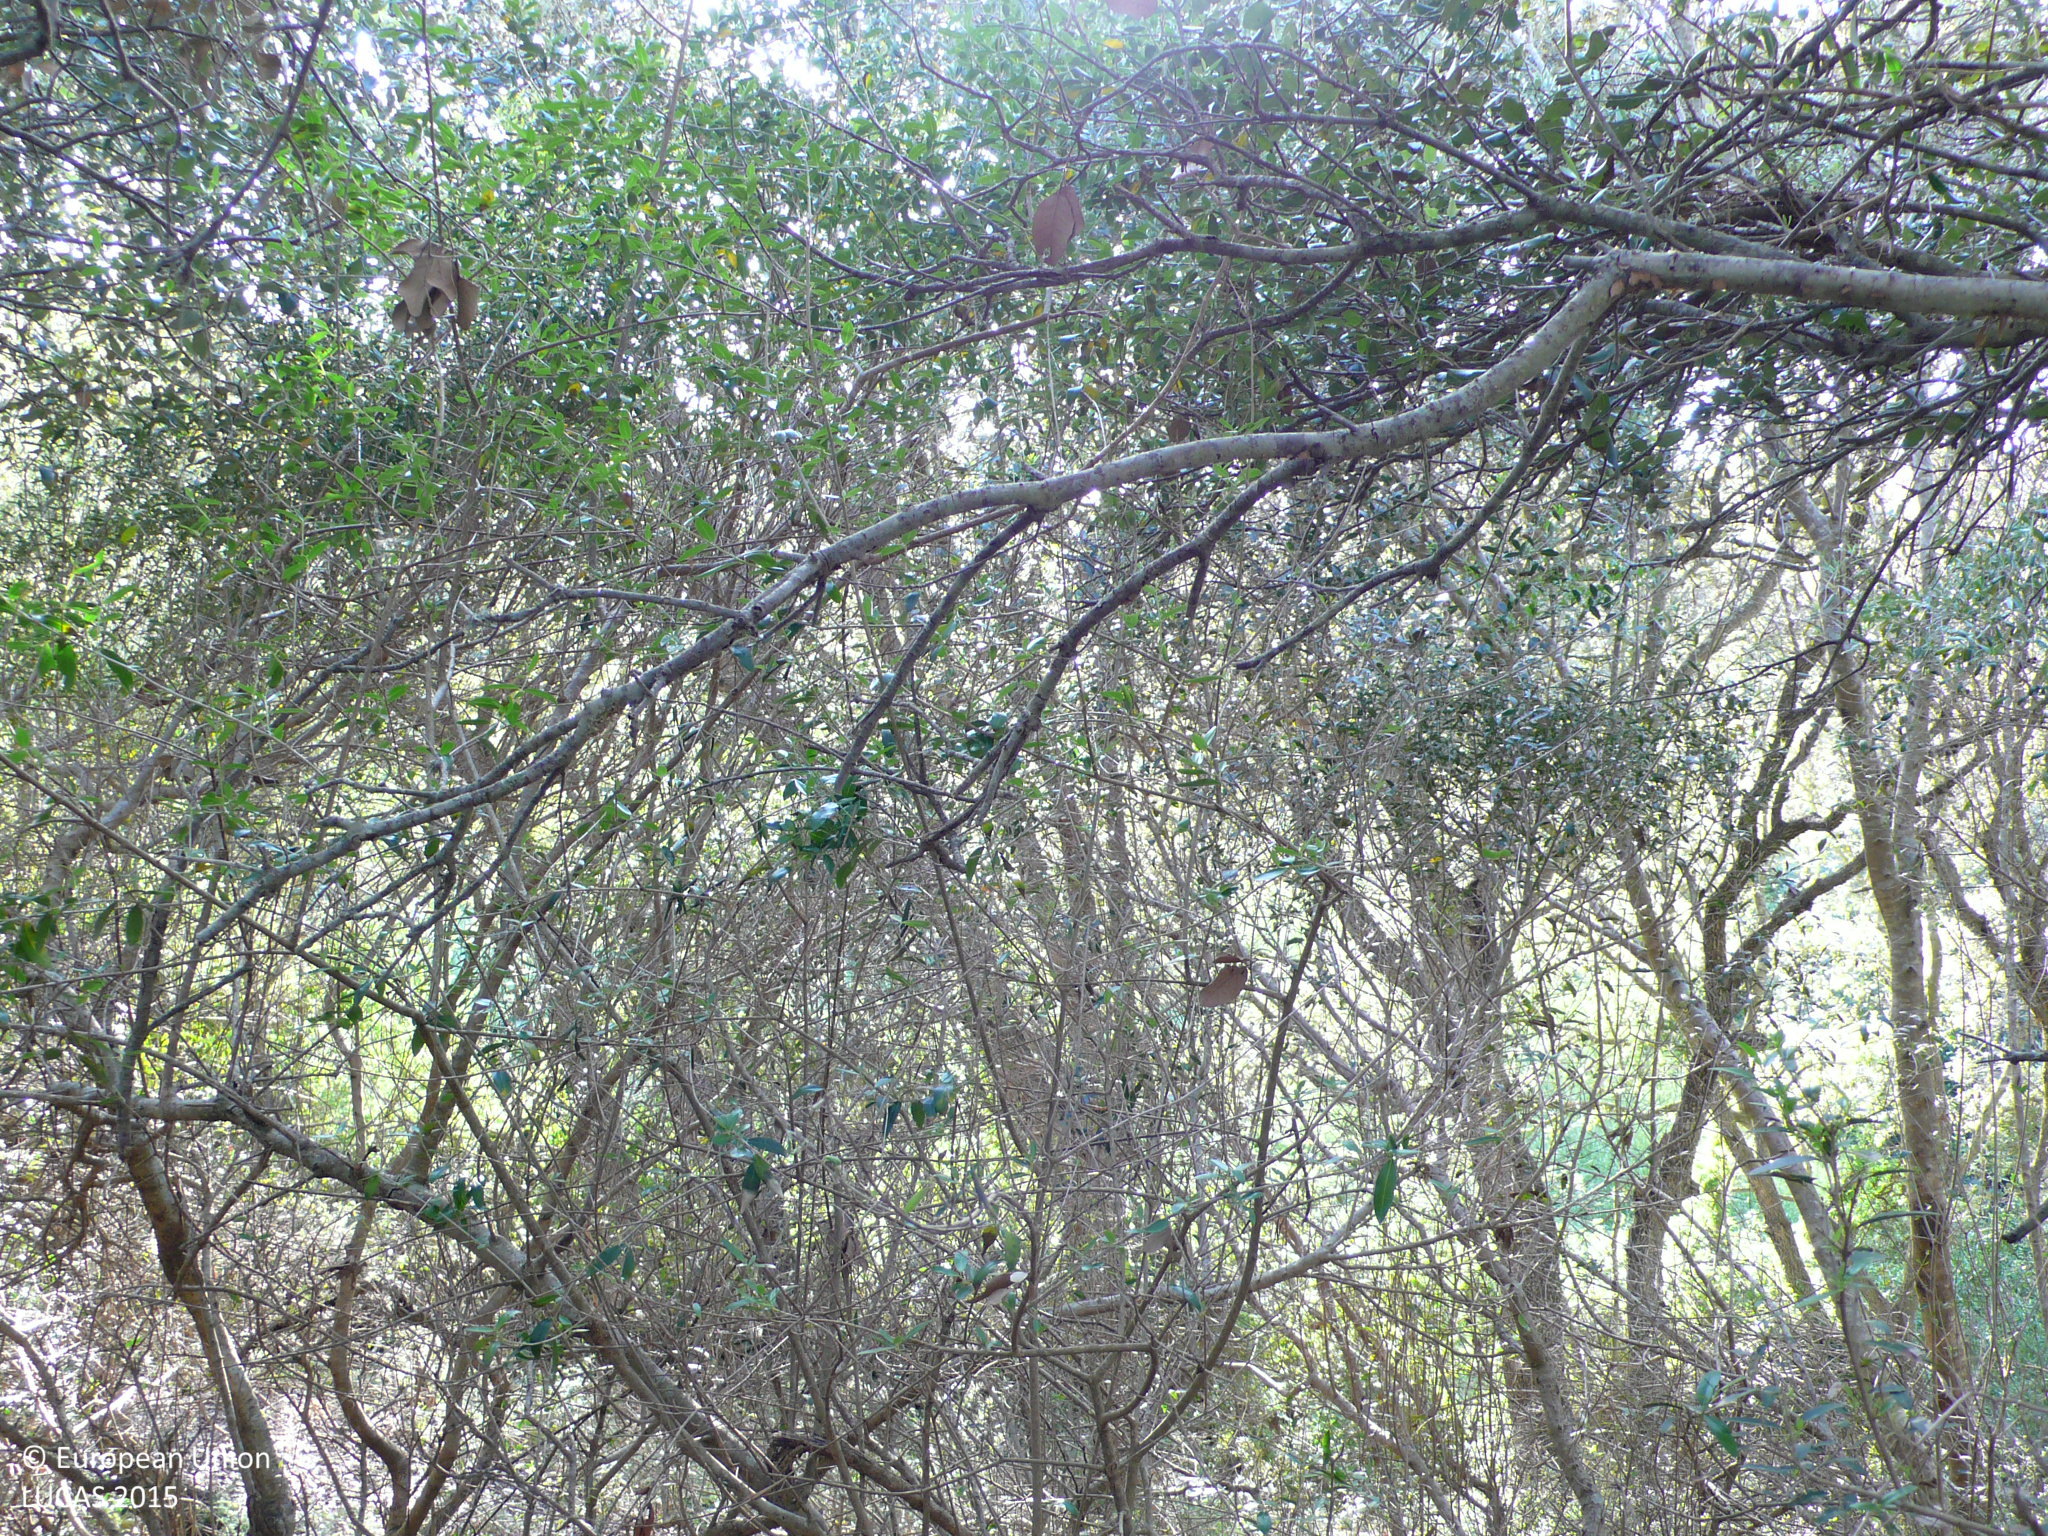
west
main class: Woodland
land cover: Broadleaved woodland
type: thermophilous deciduous forest
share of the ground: > 75 %
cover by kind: broadleaved forest trees 90 %, shrubs 10 %
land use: Semi-natural and natural areas not in use
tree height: > 5 m
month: May
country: ES
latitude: 39.9982
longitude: 4.0874
